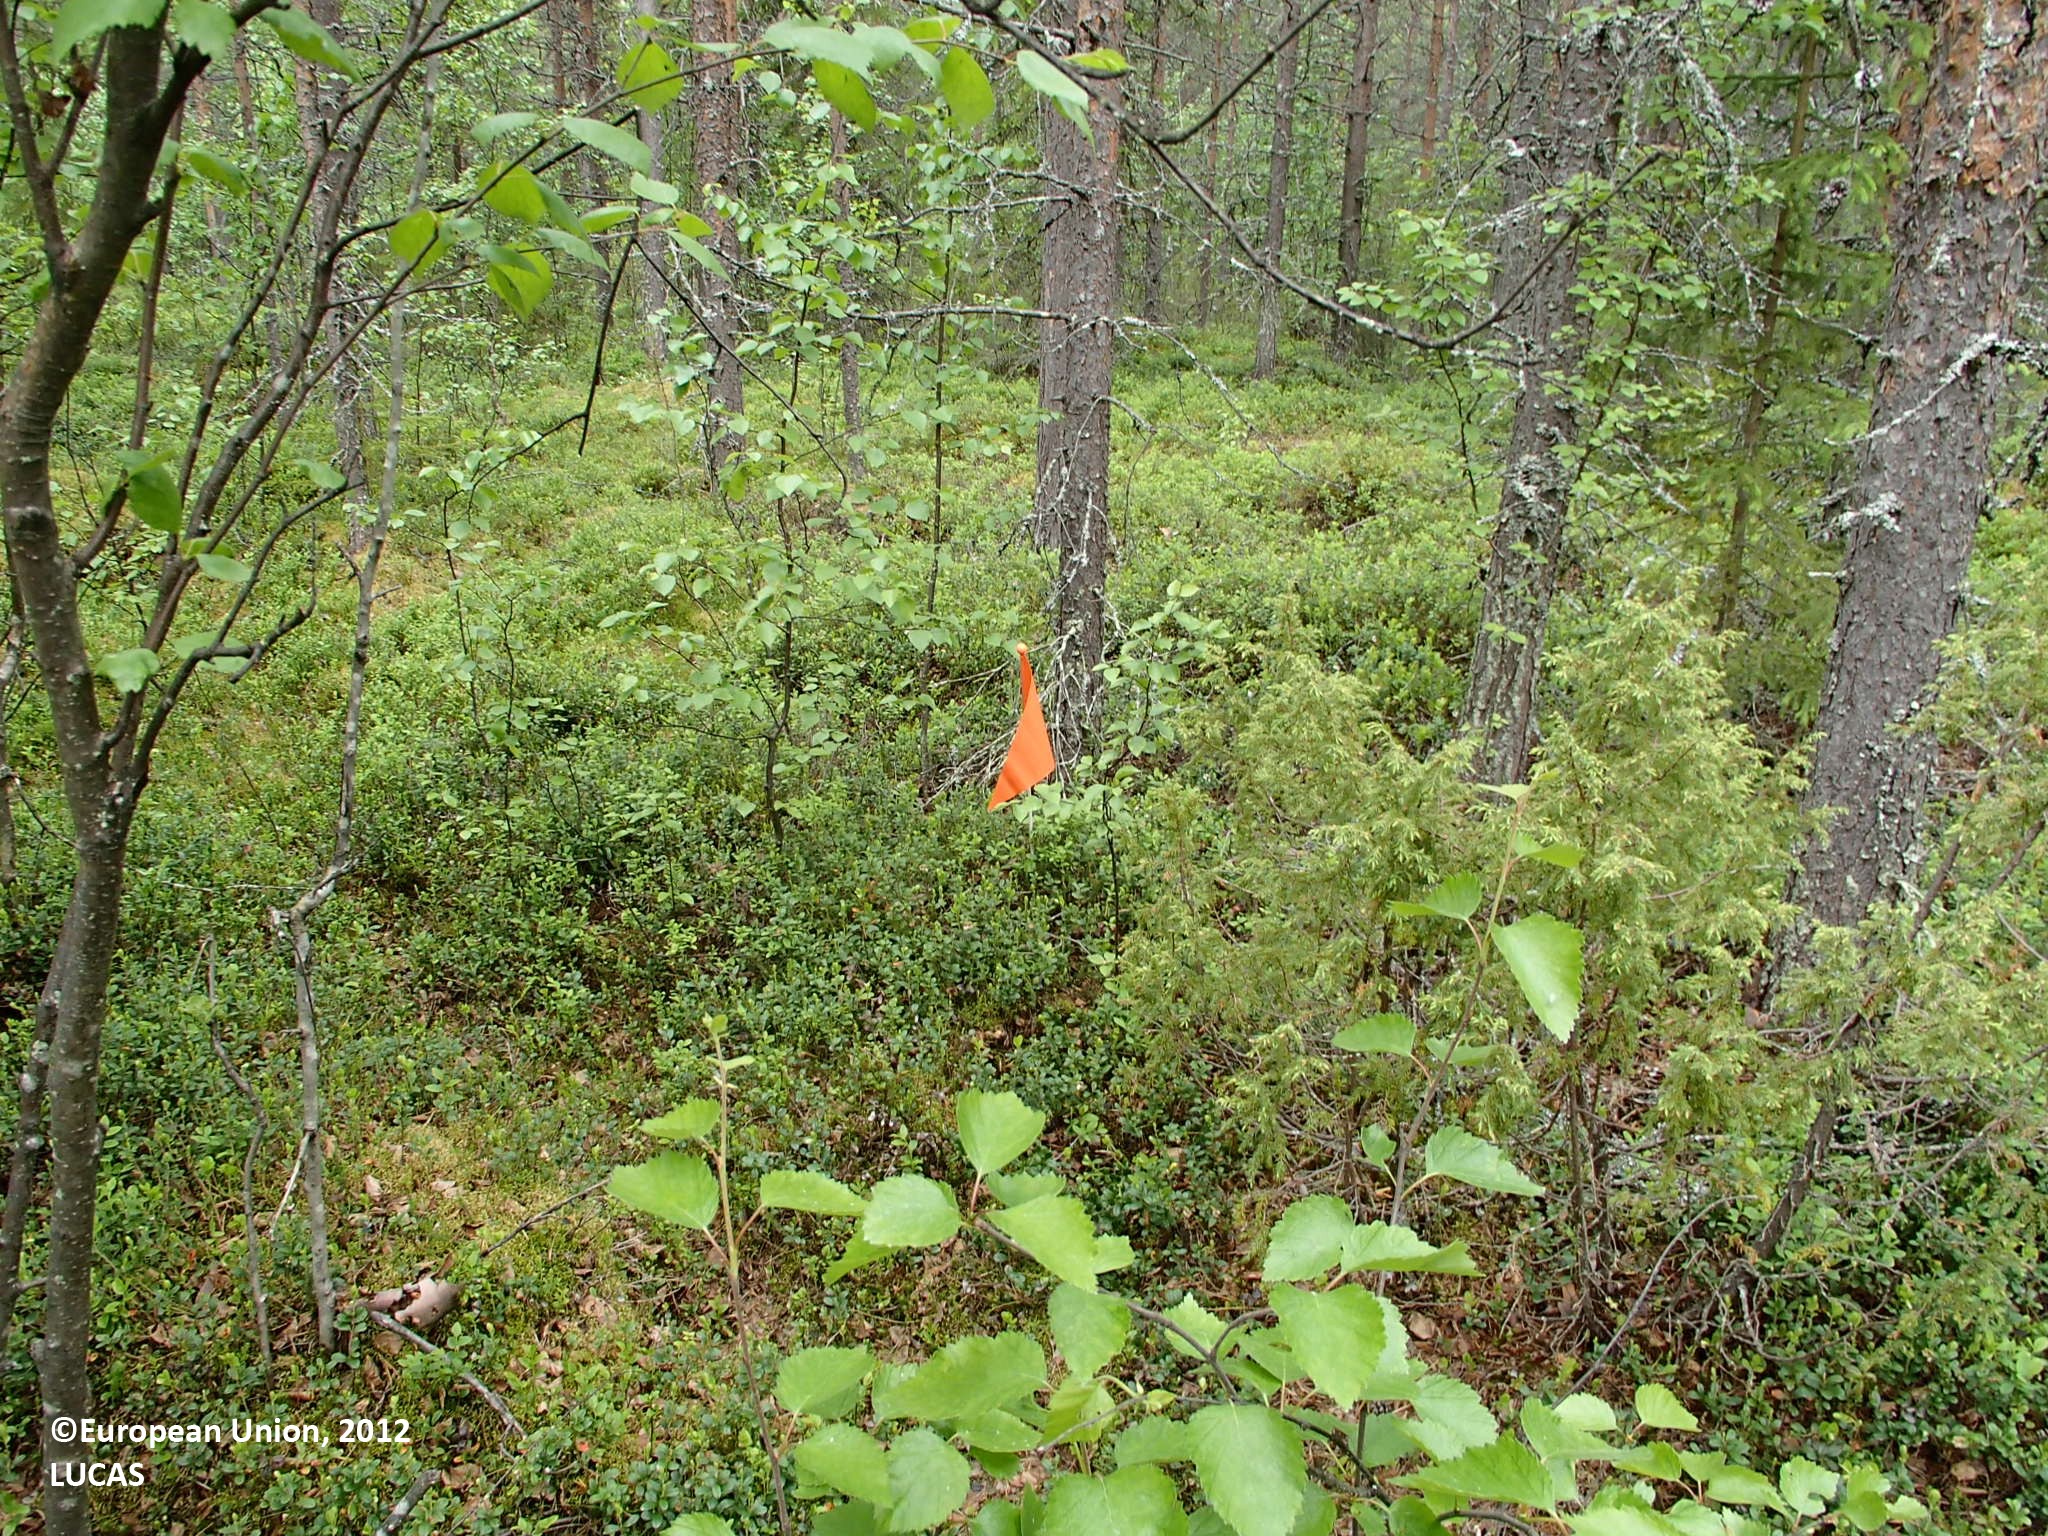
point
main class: Woodland
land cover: Pine dominated coniferous woodland
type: boreal forest
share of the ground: > 75 %
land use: Forestry
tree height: > 5 m
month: June
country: FI
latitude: 66.7870
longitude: 27.5027
